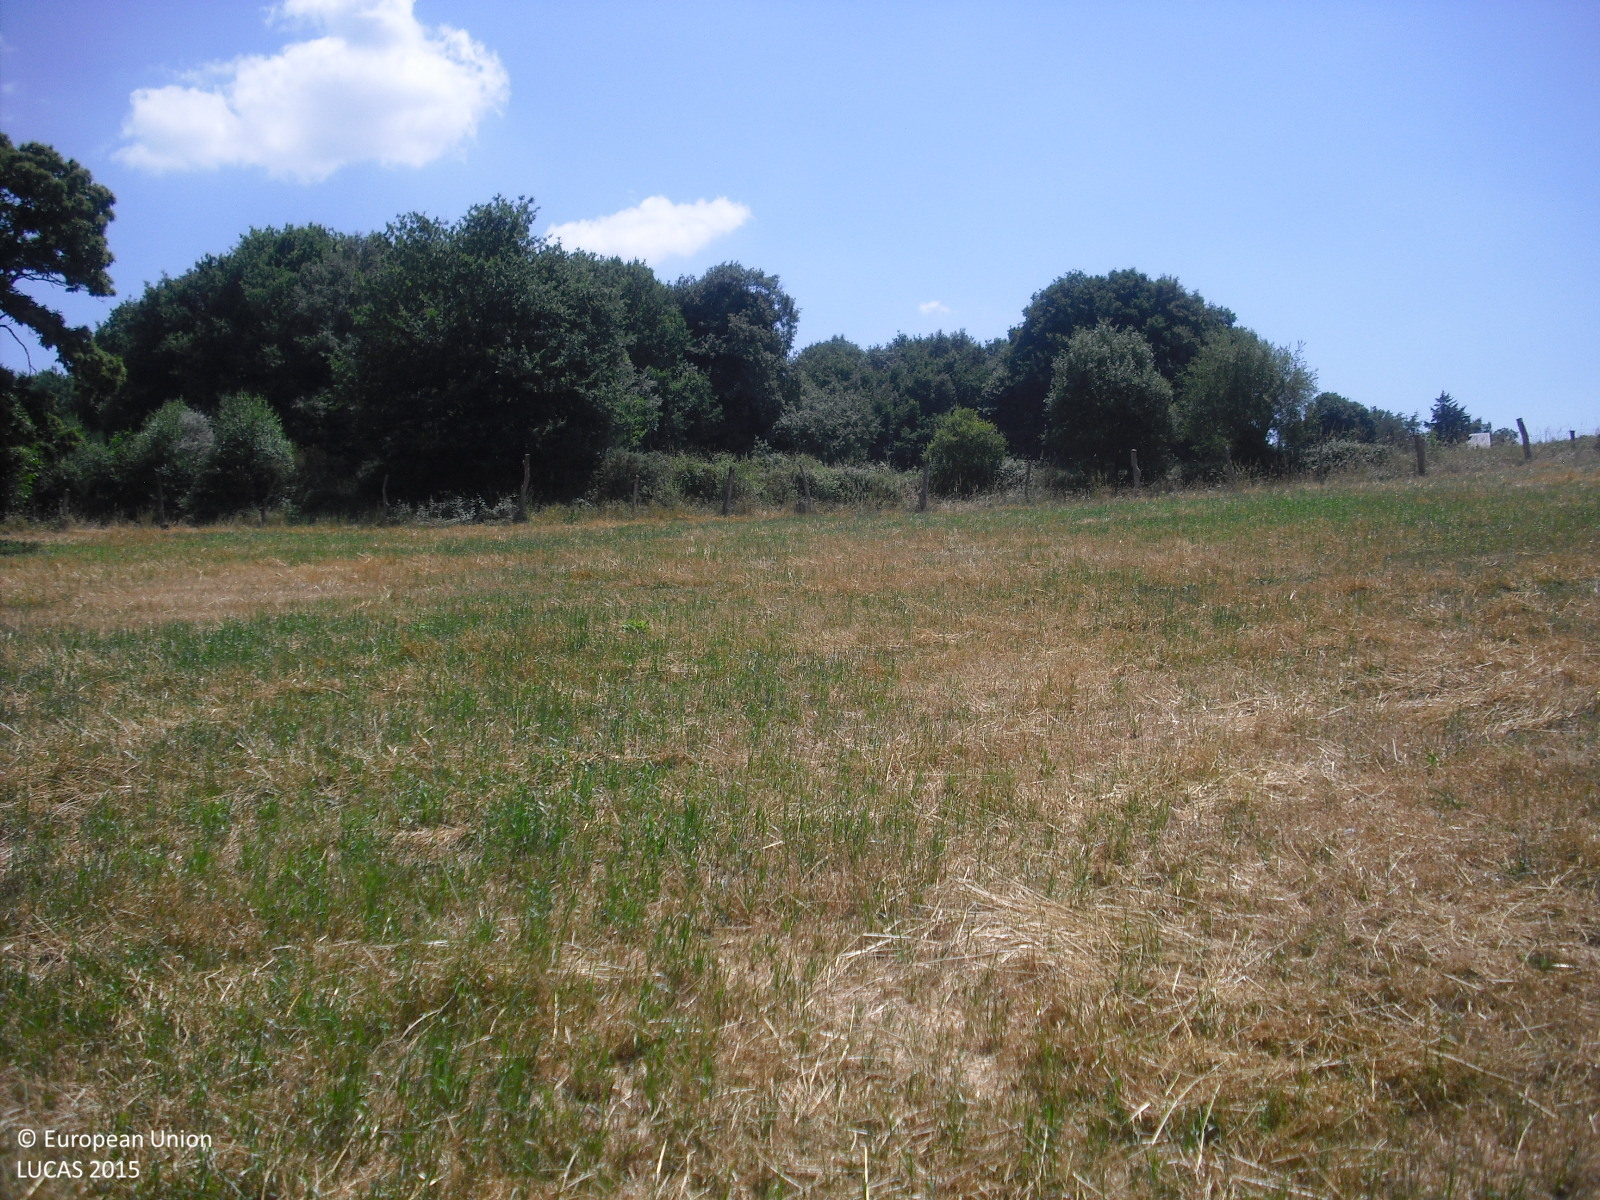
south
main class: Cropland
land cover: Temporary grasslands
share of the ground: > 75 %
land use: Agriculture (excluding fallow land and kitchen gardens)
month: June
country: ES
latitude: 42.6743
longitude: -7.7600
